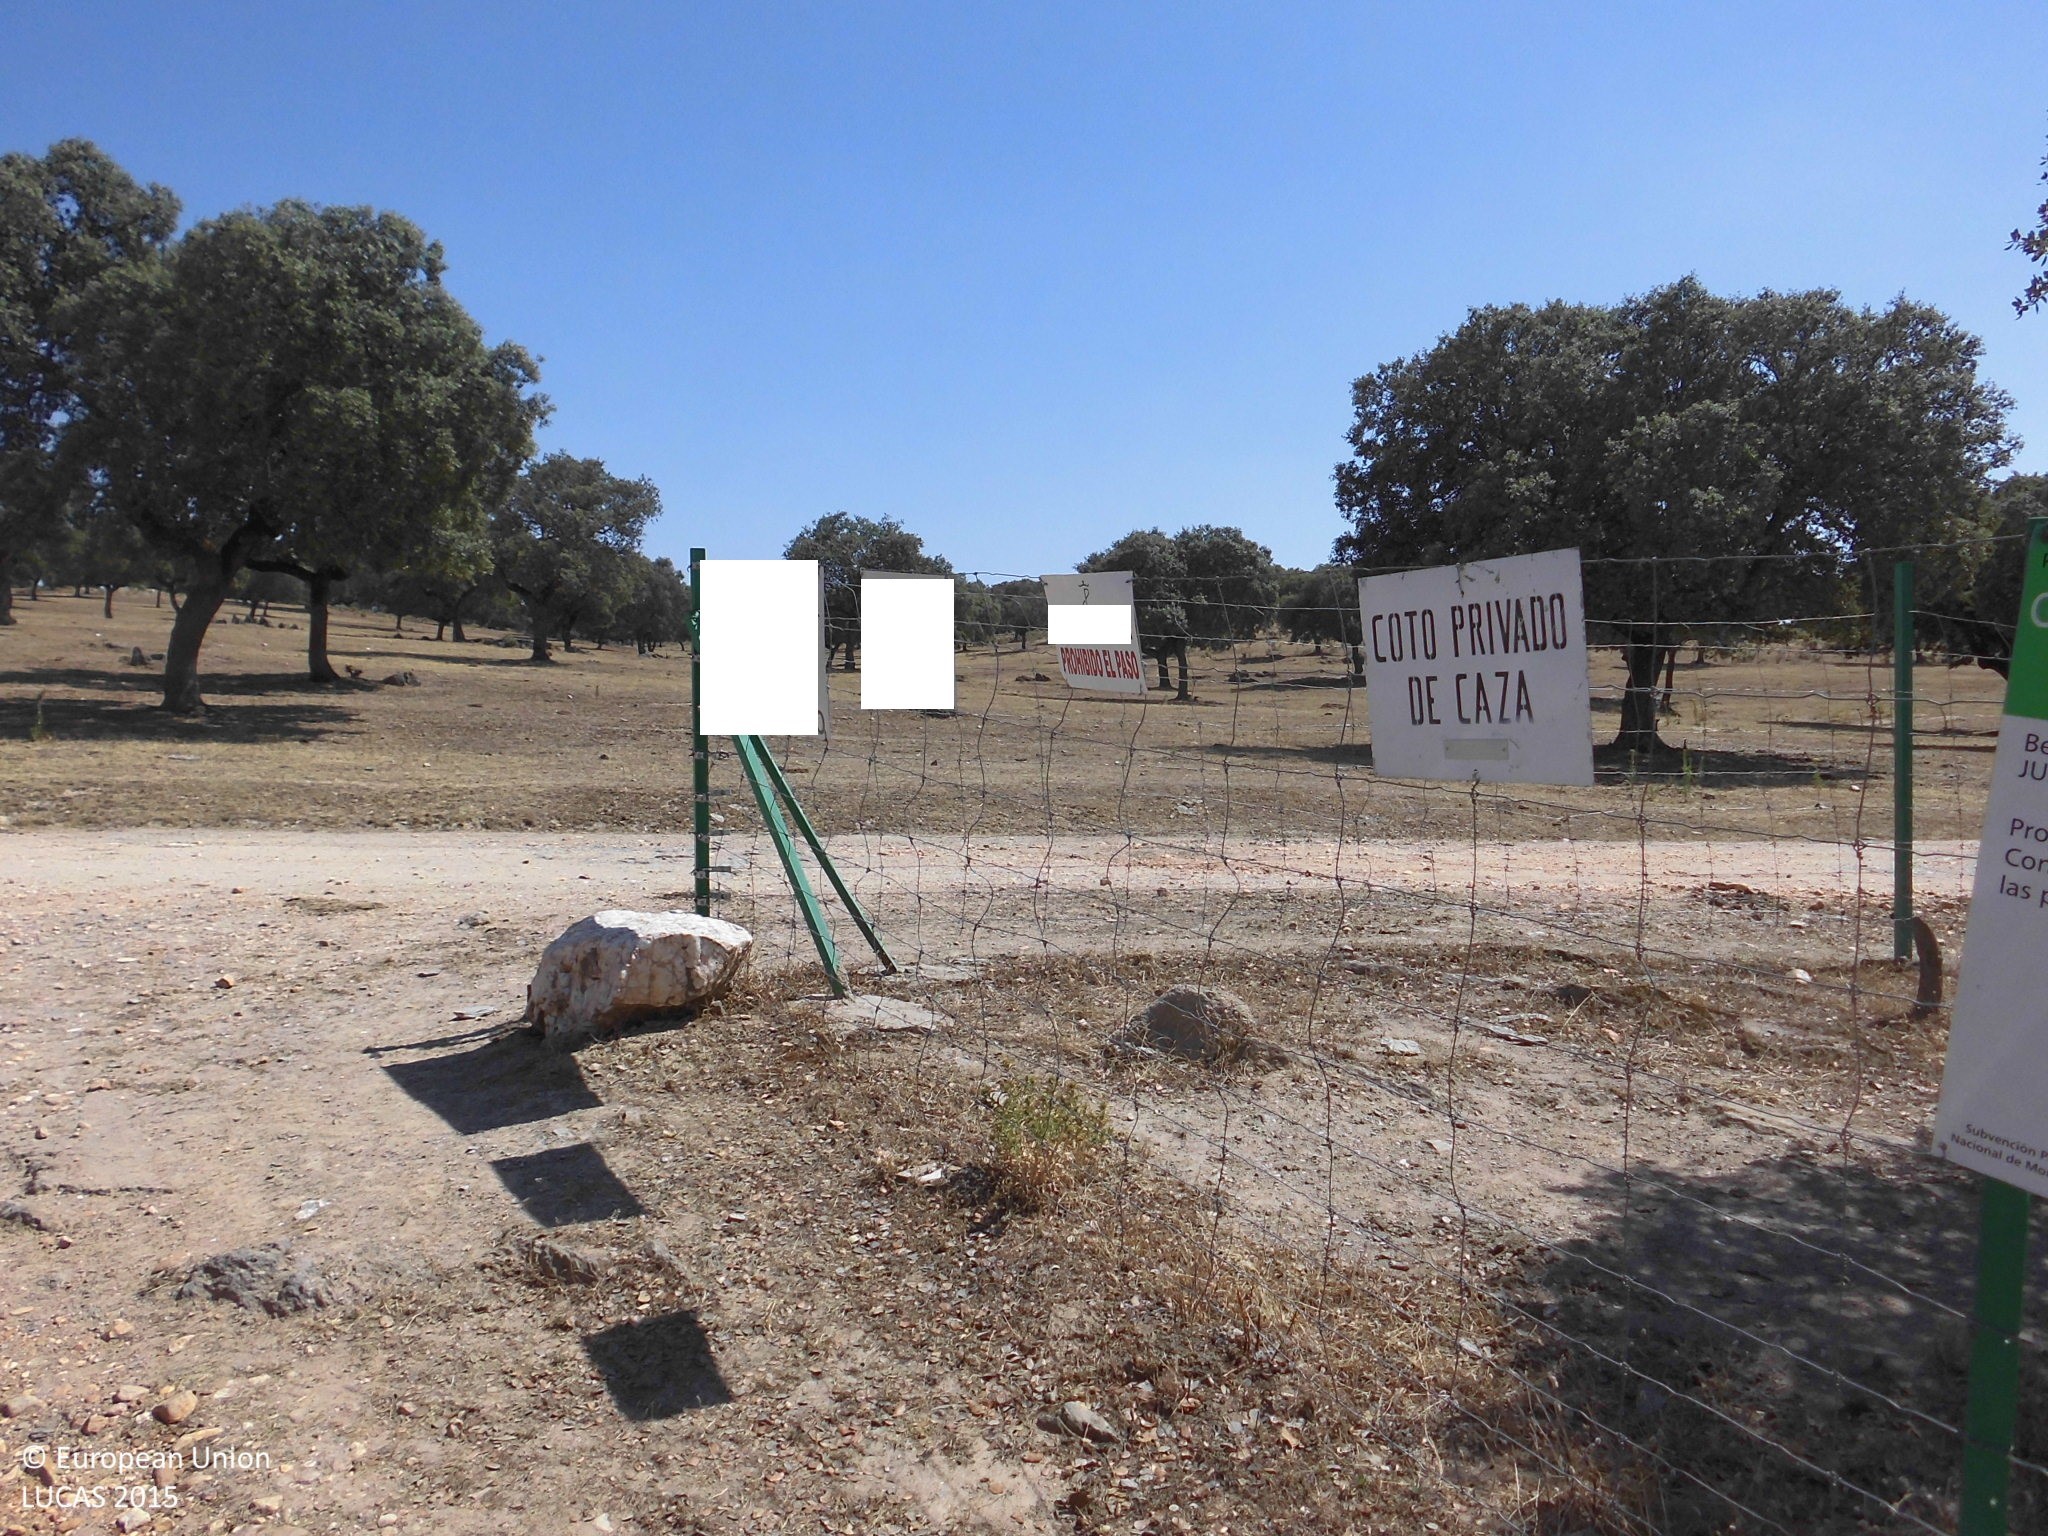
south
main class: Woodland
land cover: Broadleaved woodland
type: broadleaved evergreen forest
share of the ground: 25 - 50 %
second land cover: Grassland without tree/shrub cover
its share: > 75 %
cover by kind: herbaceous plants 65 %, broadleaved forest trees 35 %
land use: Forestry
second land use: Agriculture (excluding fallow land and kitchen gardens)
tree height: > 5 m
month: June
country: ES
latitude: 39.7849
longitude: -6.1475
